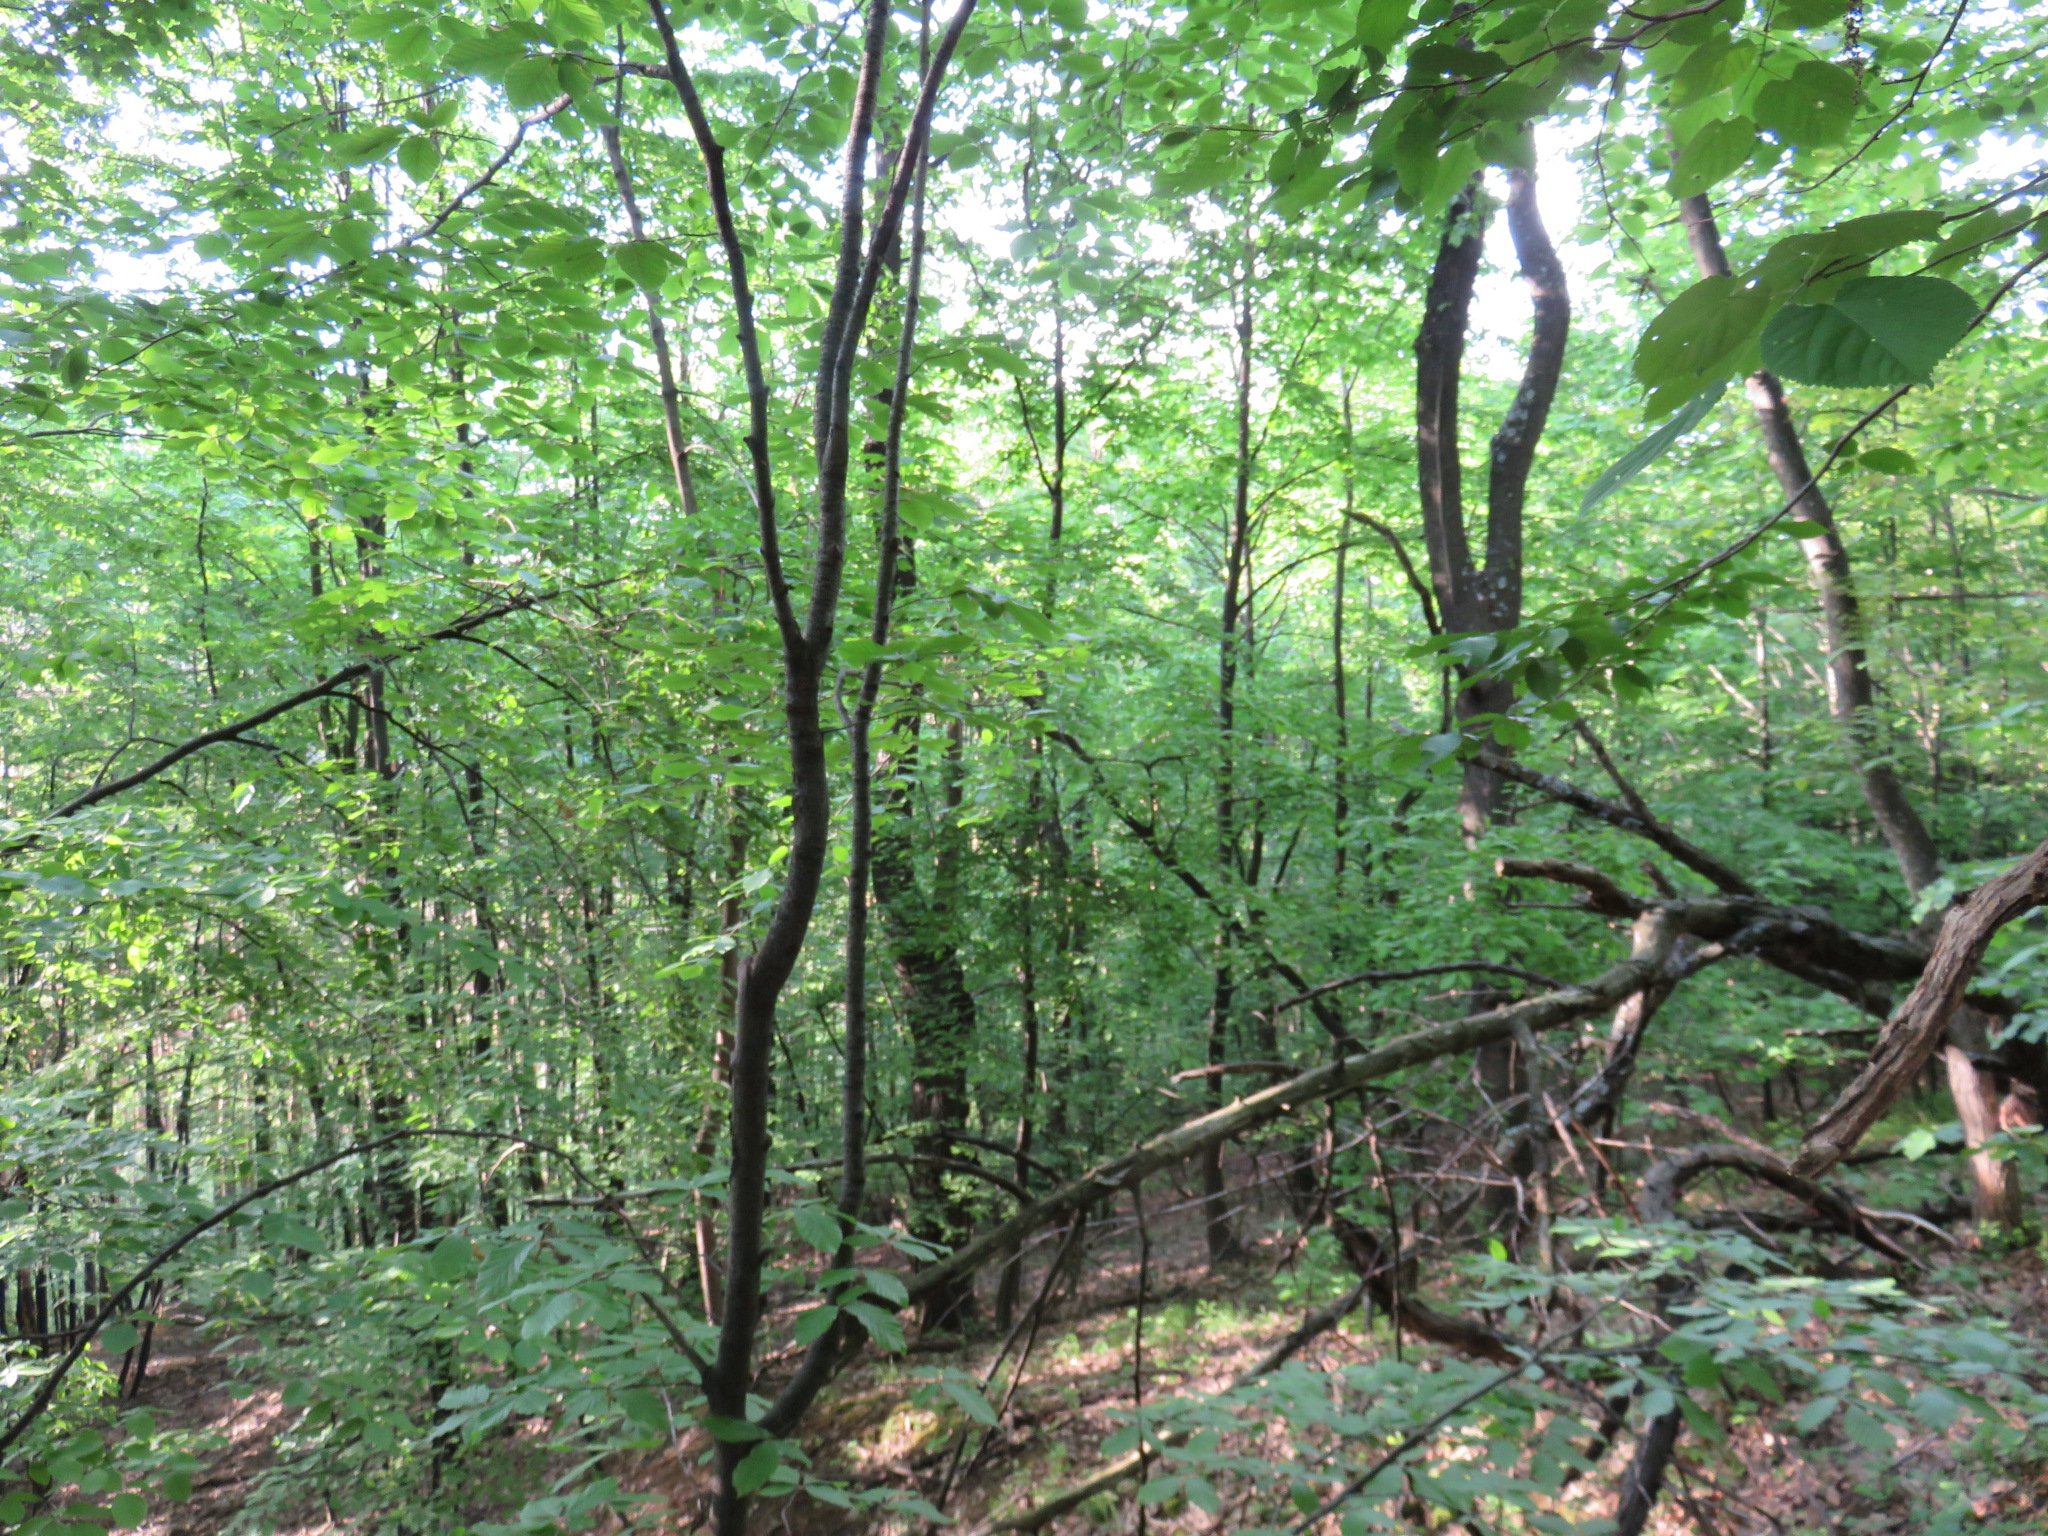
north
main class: Woodland
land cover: Broadleaved woodland
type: mesophytic deciduous forest
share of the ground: > 75 %
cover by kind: broadleaved forest trees 95 %, unconsolidated bare surface 5 %
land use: Forestry
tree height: < 5 m
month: May
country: BG
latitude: 42.8598
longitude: 24.8086
